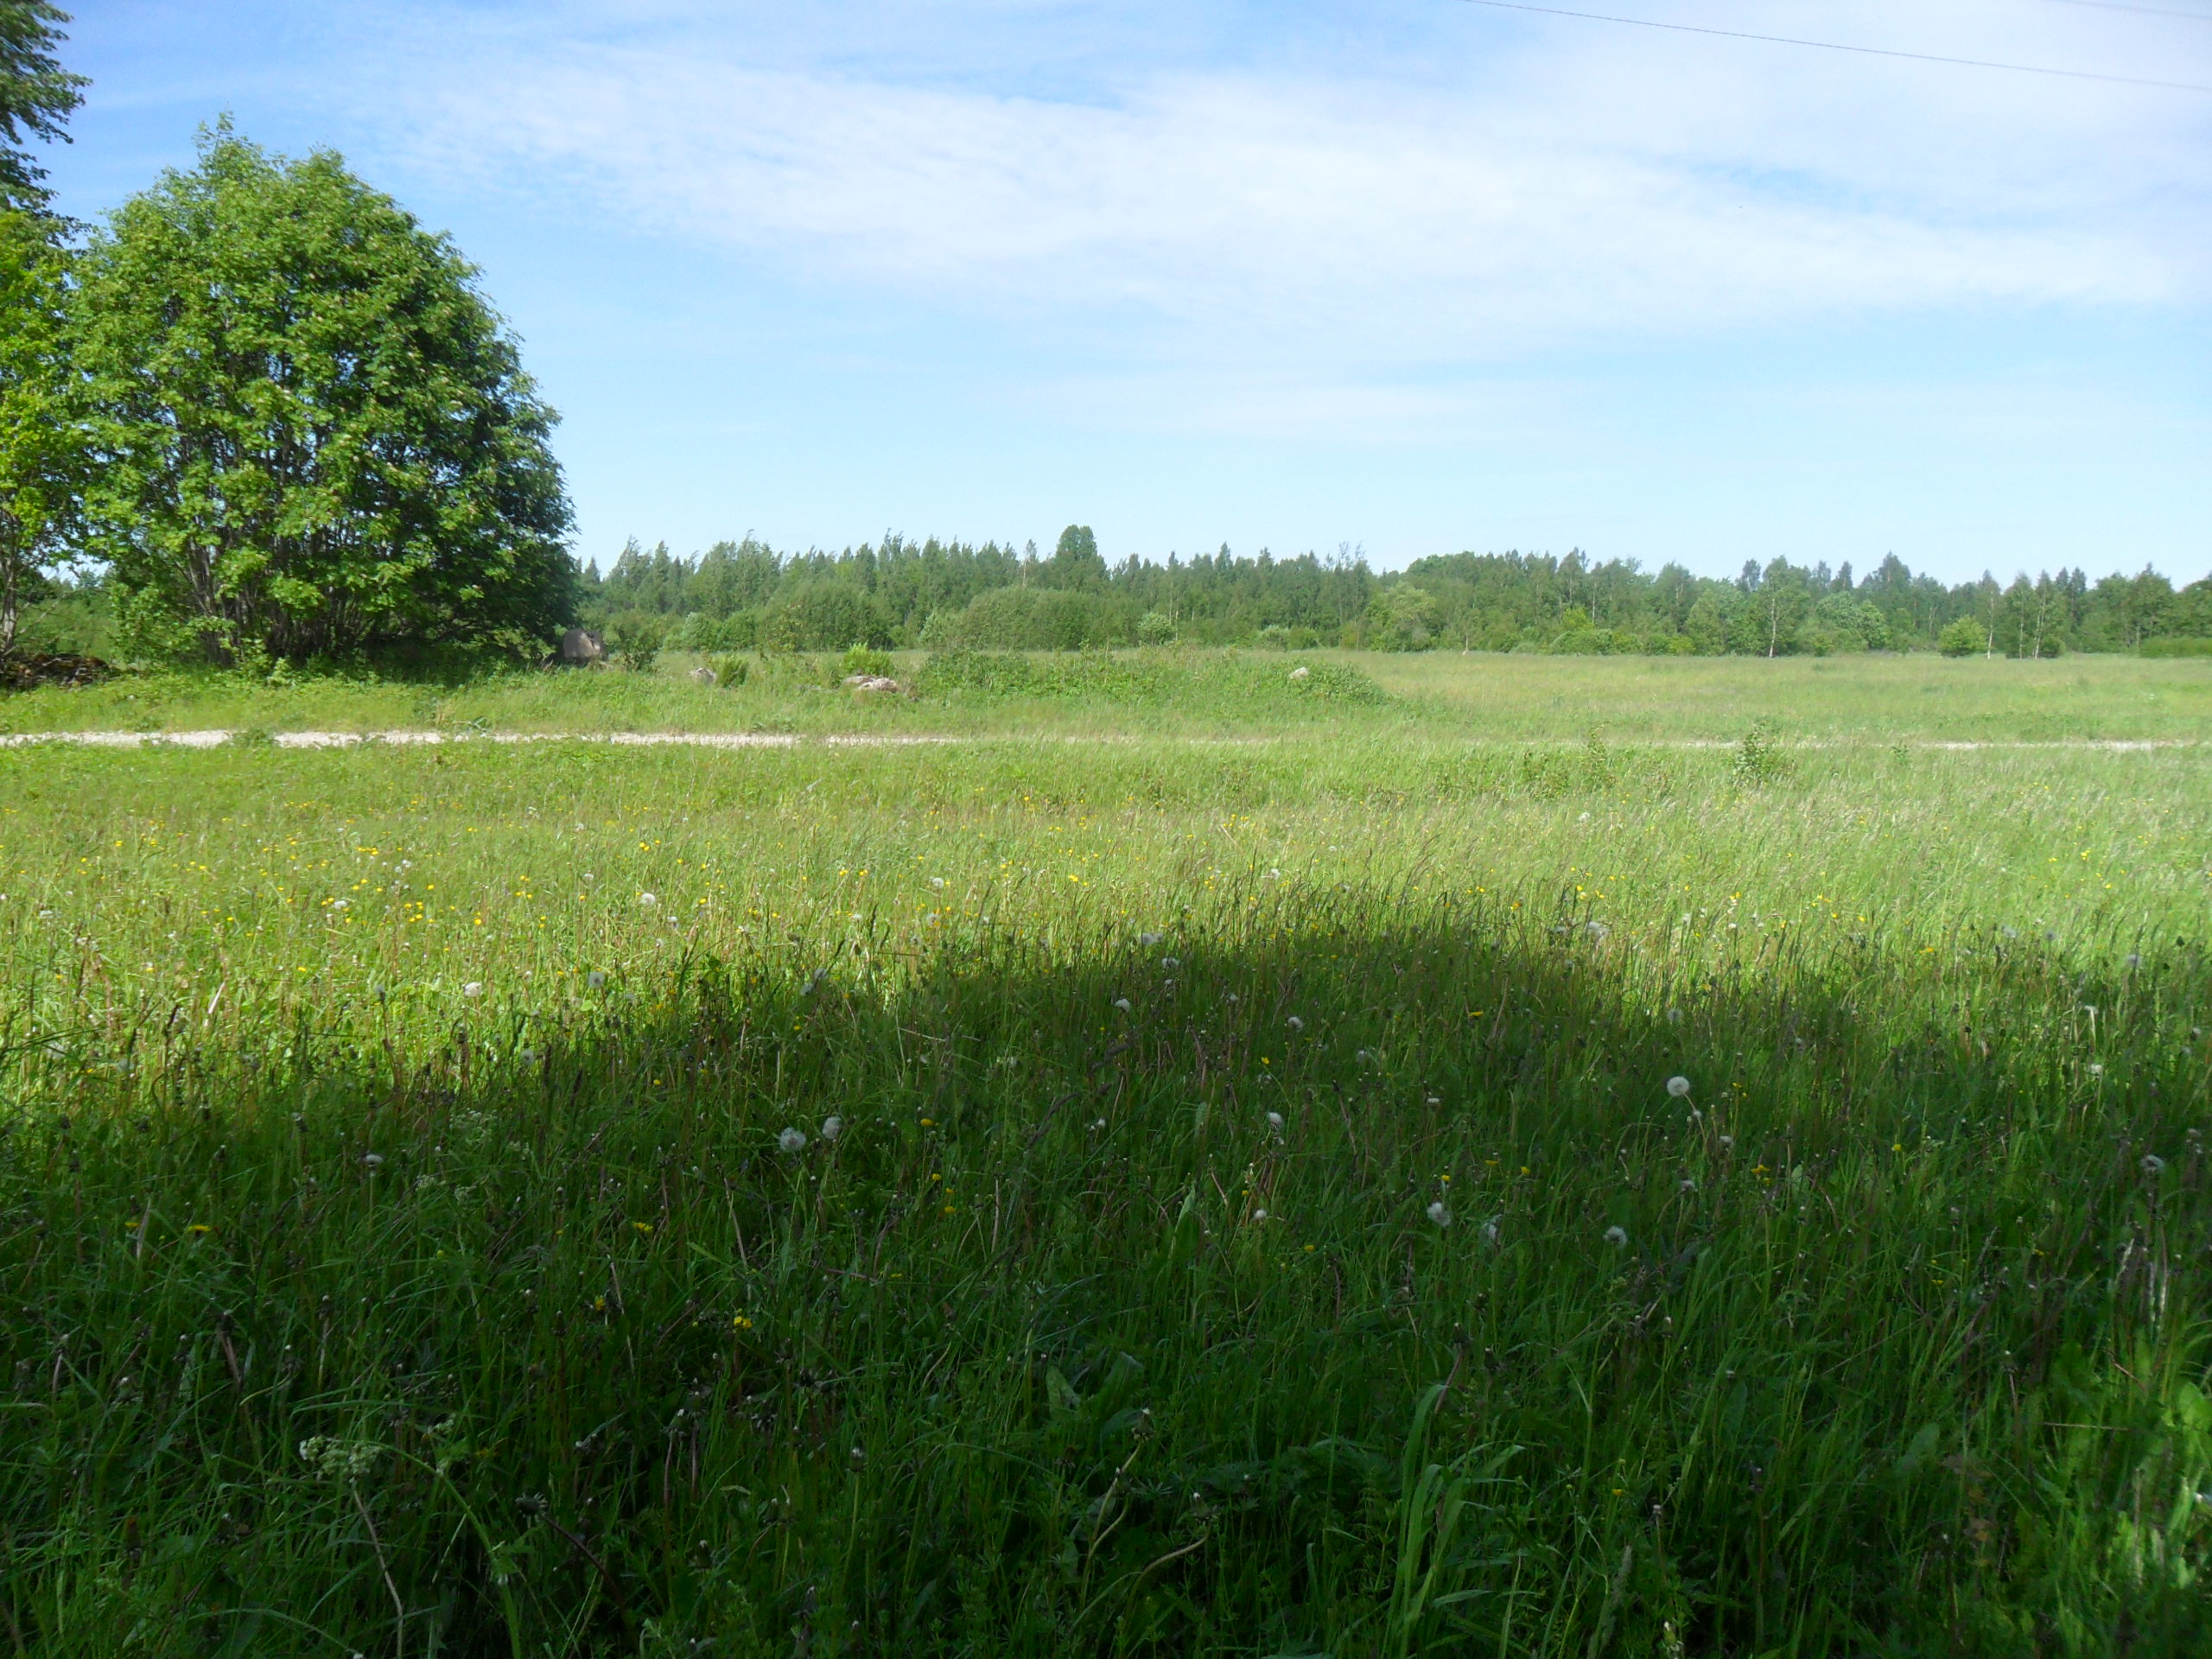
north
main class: Grassland
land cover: Grassland without tree/shrub cover
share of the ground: > 75 %
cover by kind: herbaceous plants 95 %, shrubs 5 %
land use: Agriculture (excluding fallow land and kitchen gardens)
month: June
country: LV
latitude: 57.4599
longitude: 22.4031
